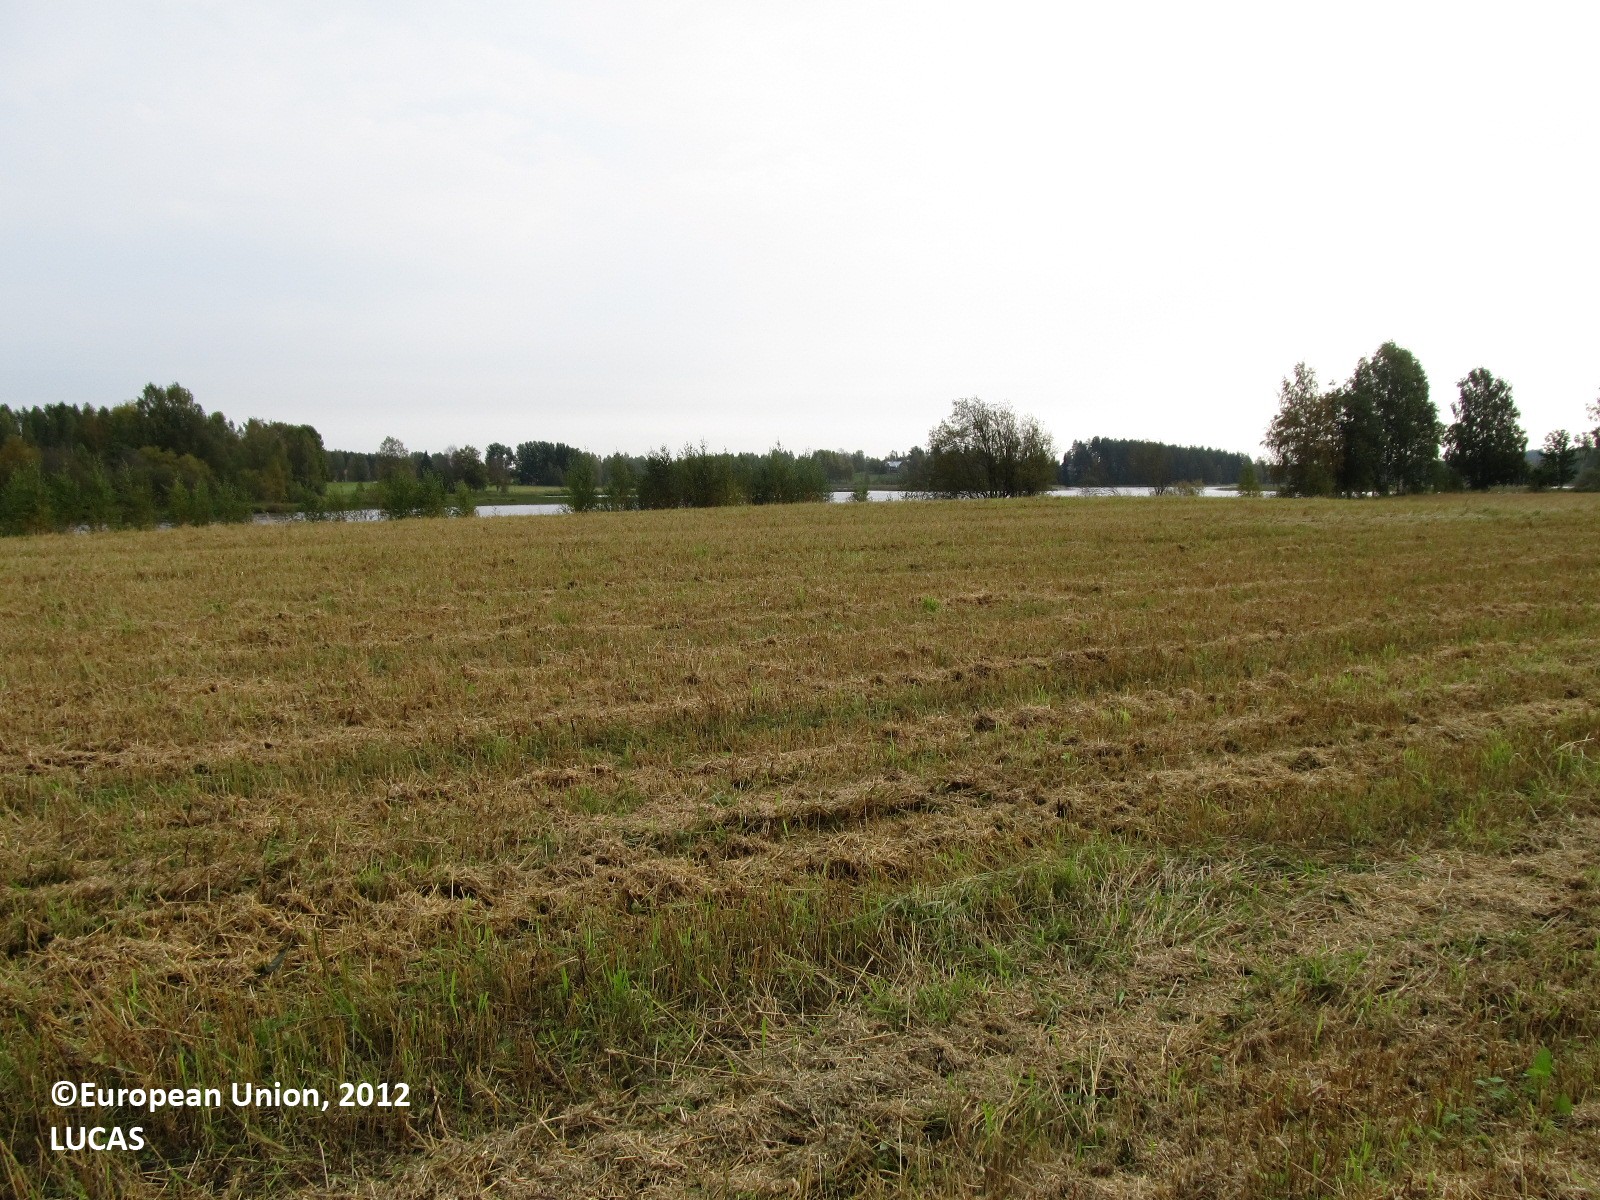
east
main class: Cropland
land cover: Common wheat
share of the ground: 50 - 75 %
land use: Agriculture (excluding fallow land and kitchen gardens)
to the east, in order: Common wheat; Broadleaved woodland; Grassland without tree/shrub cover; Inland water bodies
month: September
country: FI
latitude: 63.0115
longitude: 28.2184
